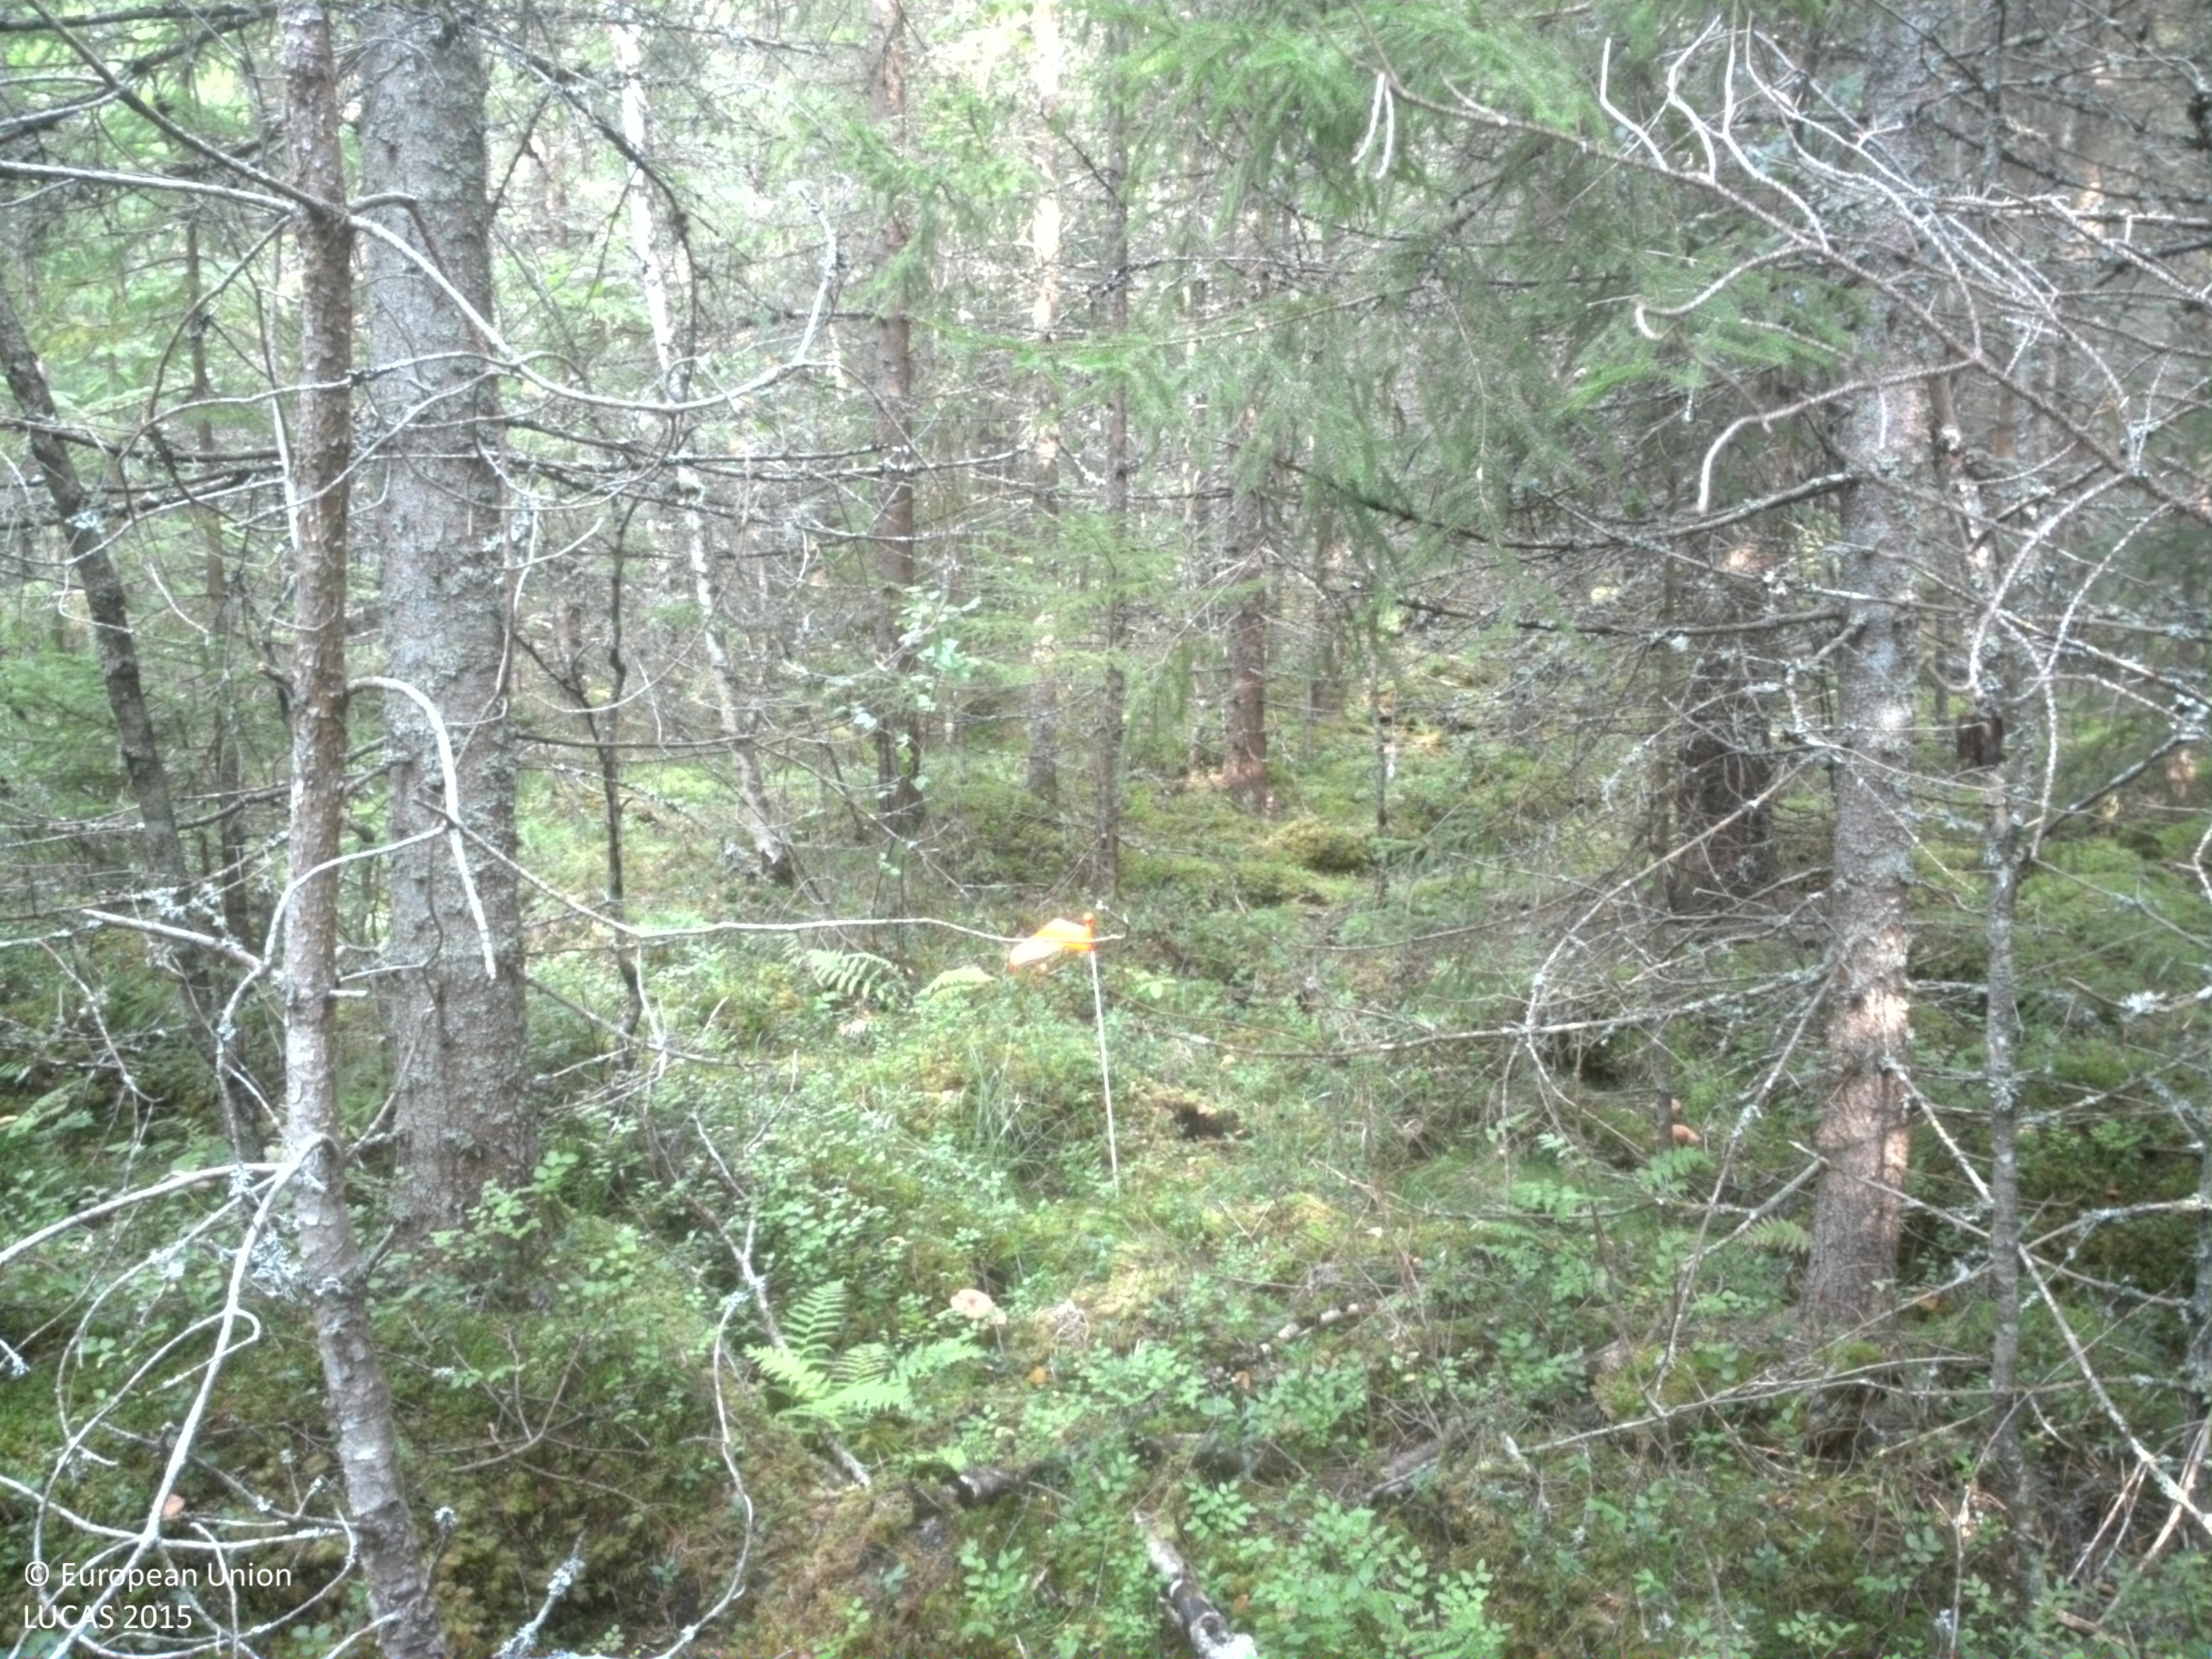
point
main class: Woodland
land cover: Spruce dominated coniferous woodland
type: boreal forest
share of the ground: > 75 %
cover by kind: coniferous forest trees 70 %, lichens and mosses 15 %, shrubs 10 %, broadleaved forest trees 5 %
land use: Forestry
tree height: > 5 m
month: August
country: SE
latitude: 59.7212
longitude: 15.7337
